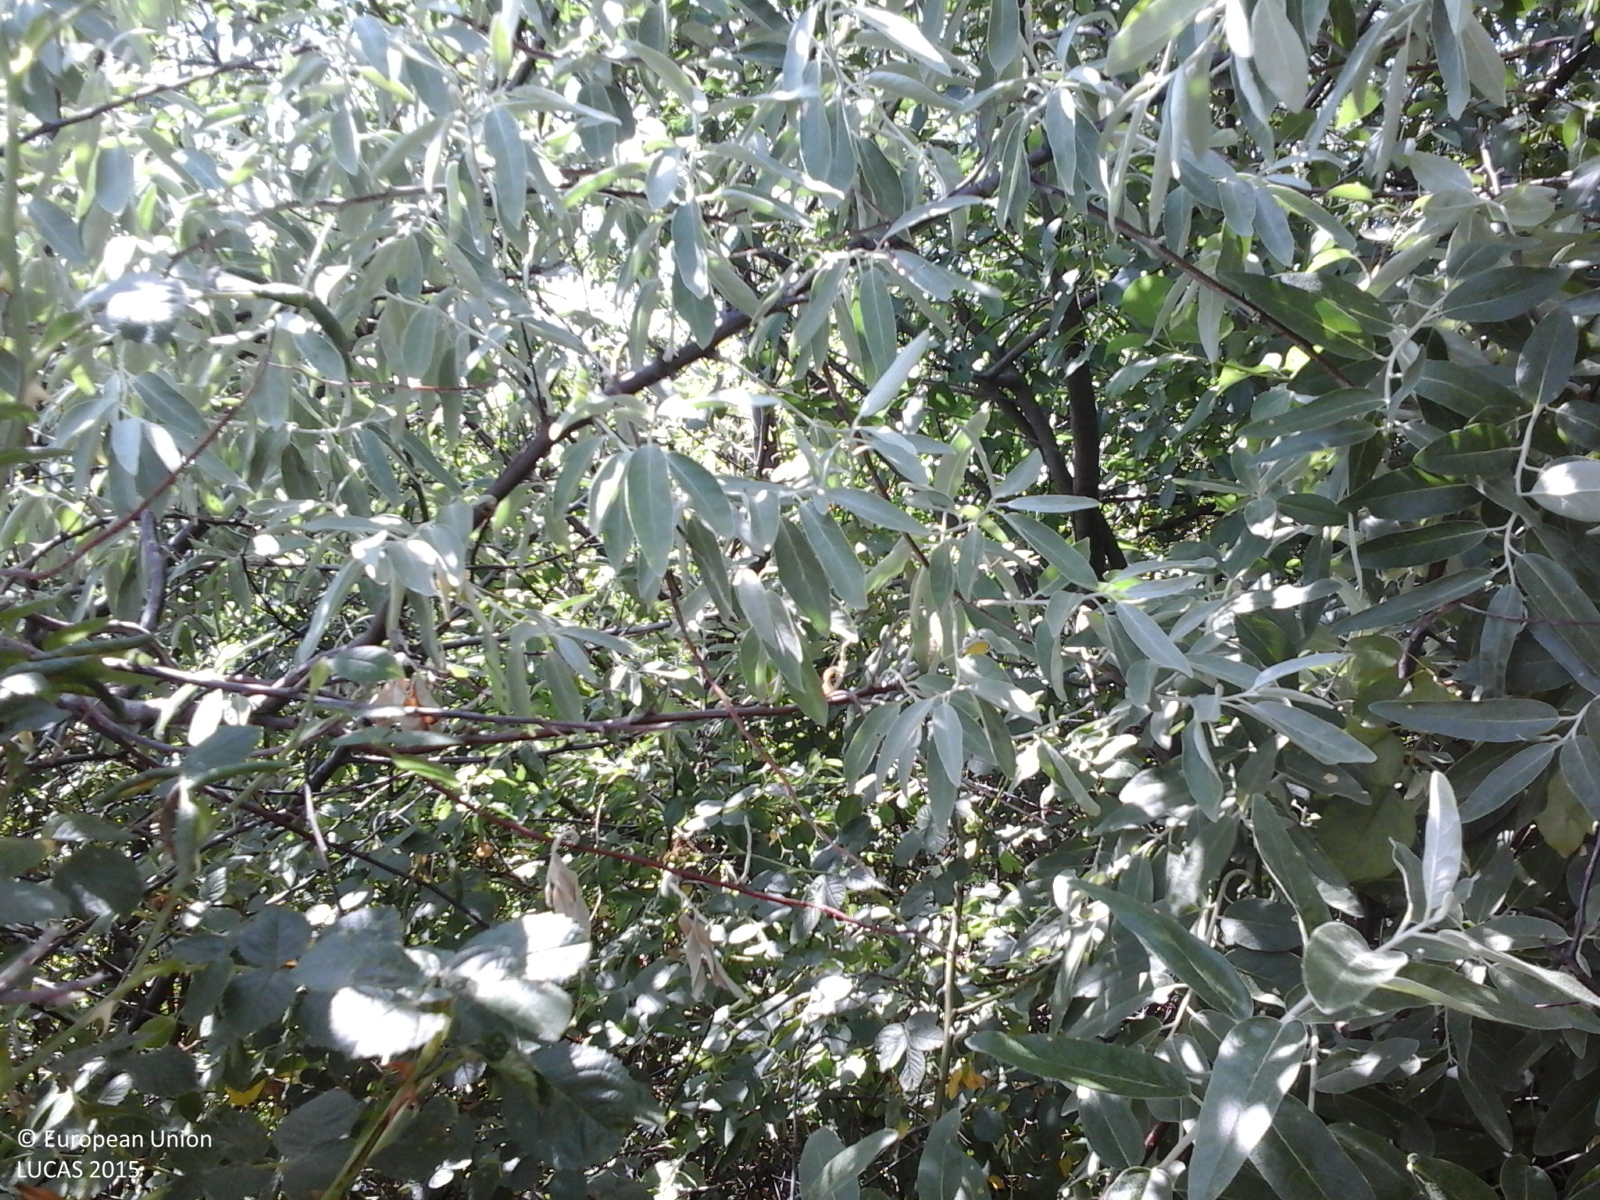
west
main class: Shrubland
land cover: Shrubland with sparse tree cover
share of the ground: > 75 %
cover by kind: shrubs 80 %, herbaceous plants 15 %, broadleaved forest trees 5 %
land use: Agriculture (excluding fallow land and kitchen gardens)
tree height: > 5 m
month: June
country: RO
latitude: 47.5141
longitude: 27.0073
